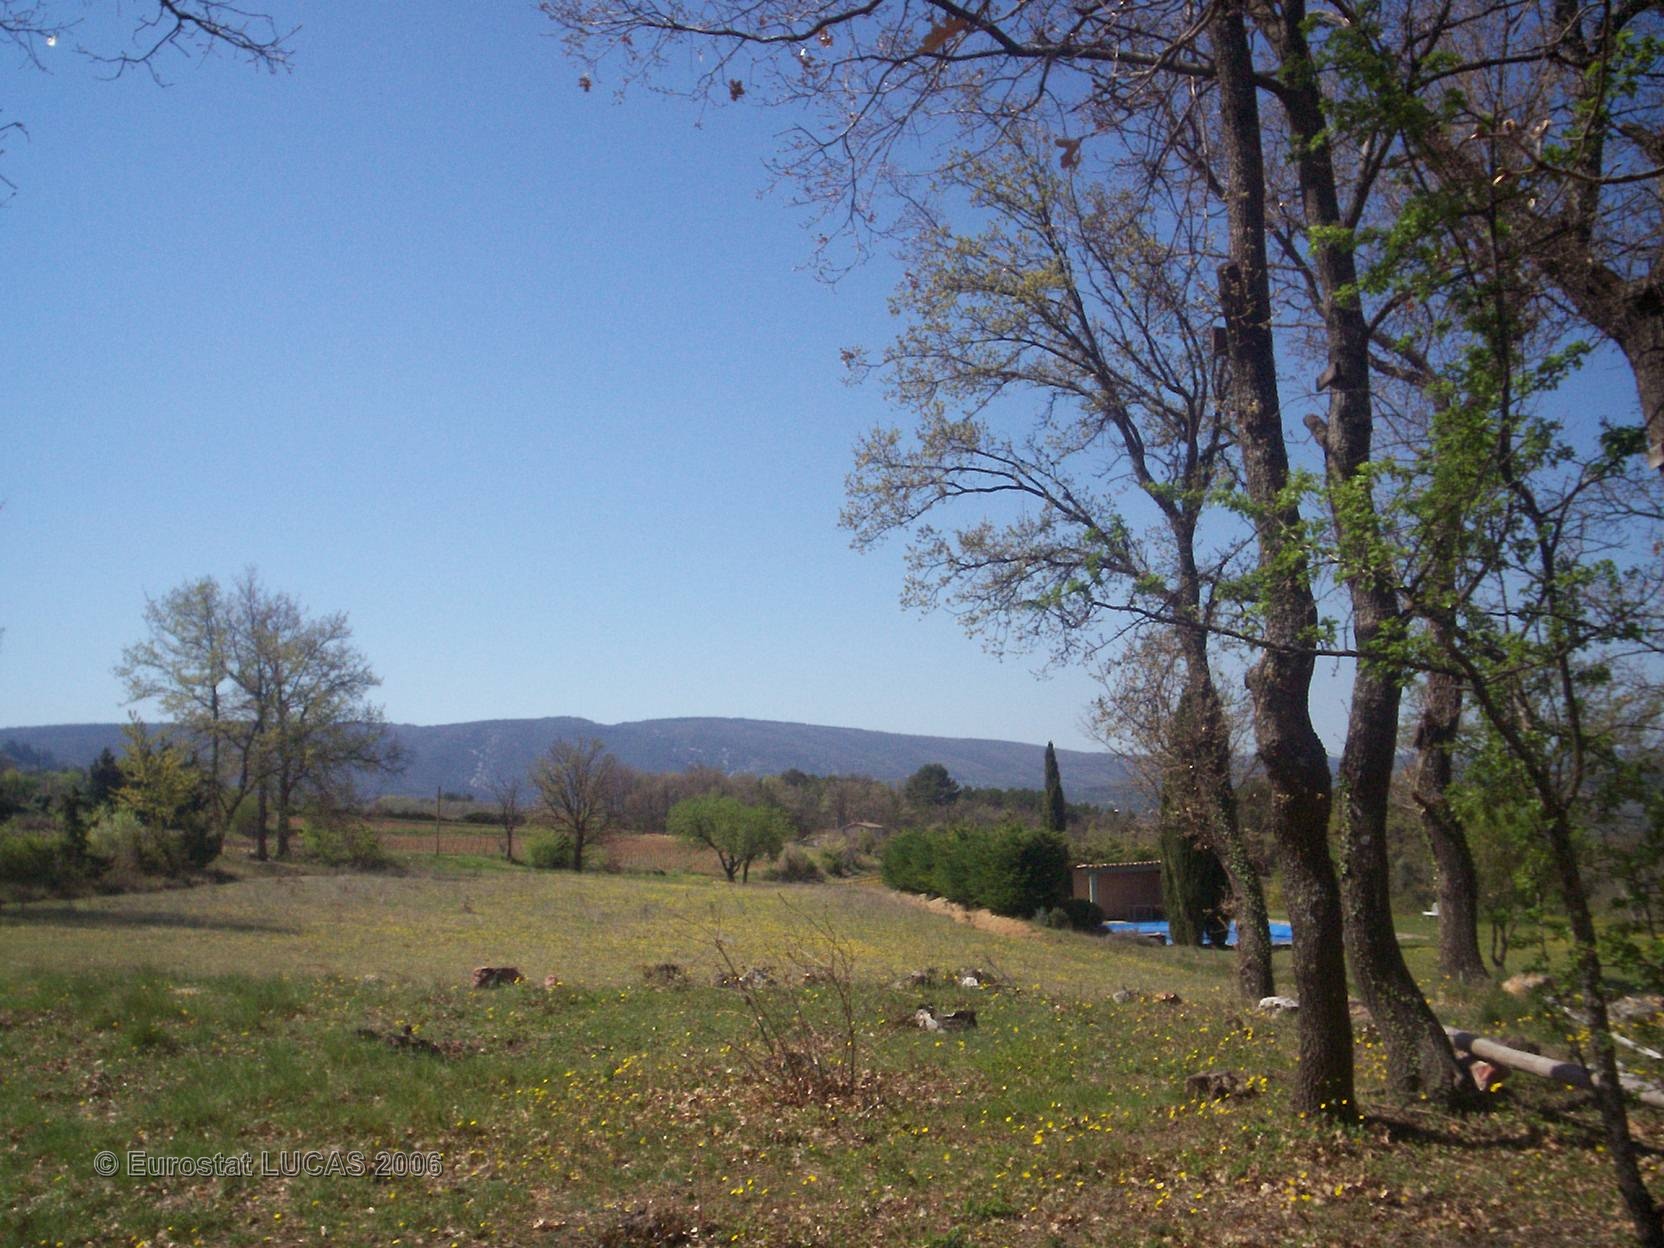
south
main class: Woodland
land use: Forestry
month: April
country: FR
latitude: 43.8475
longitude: 5.3193
